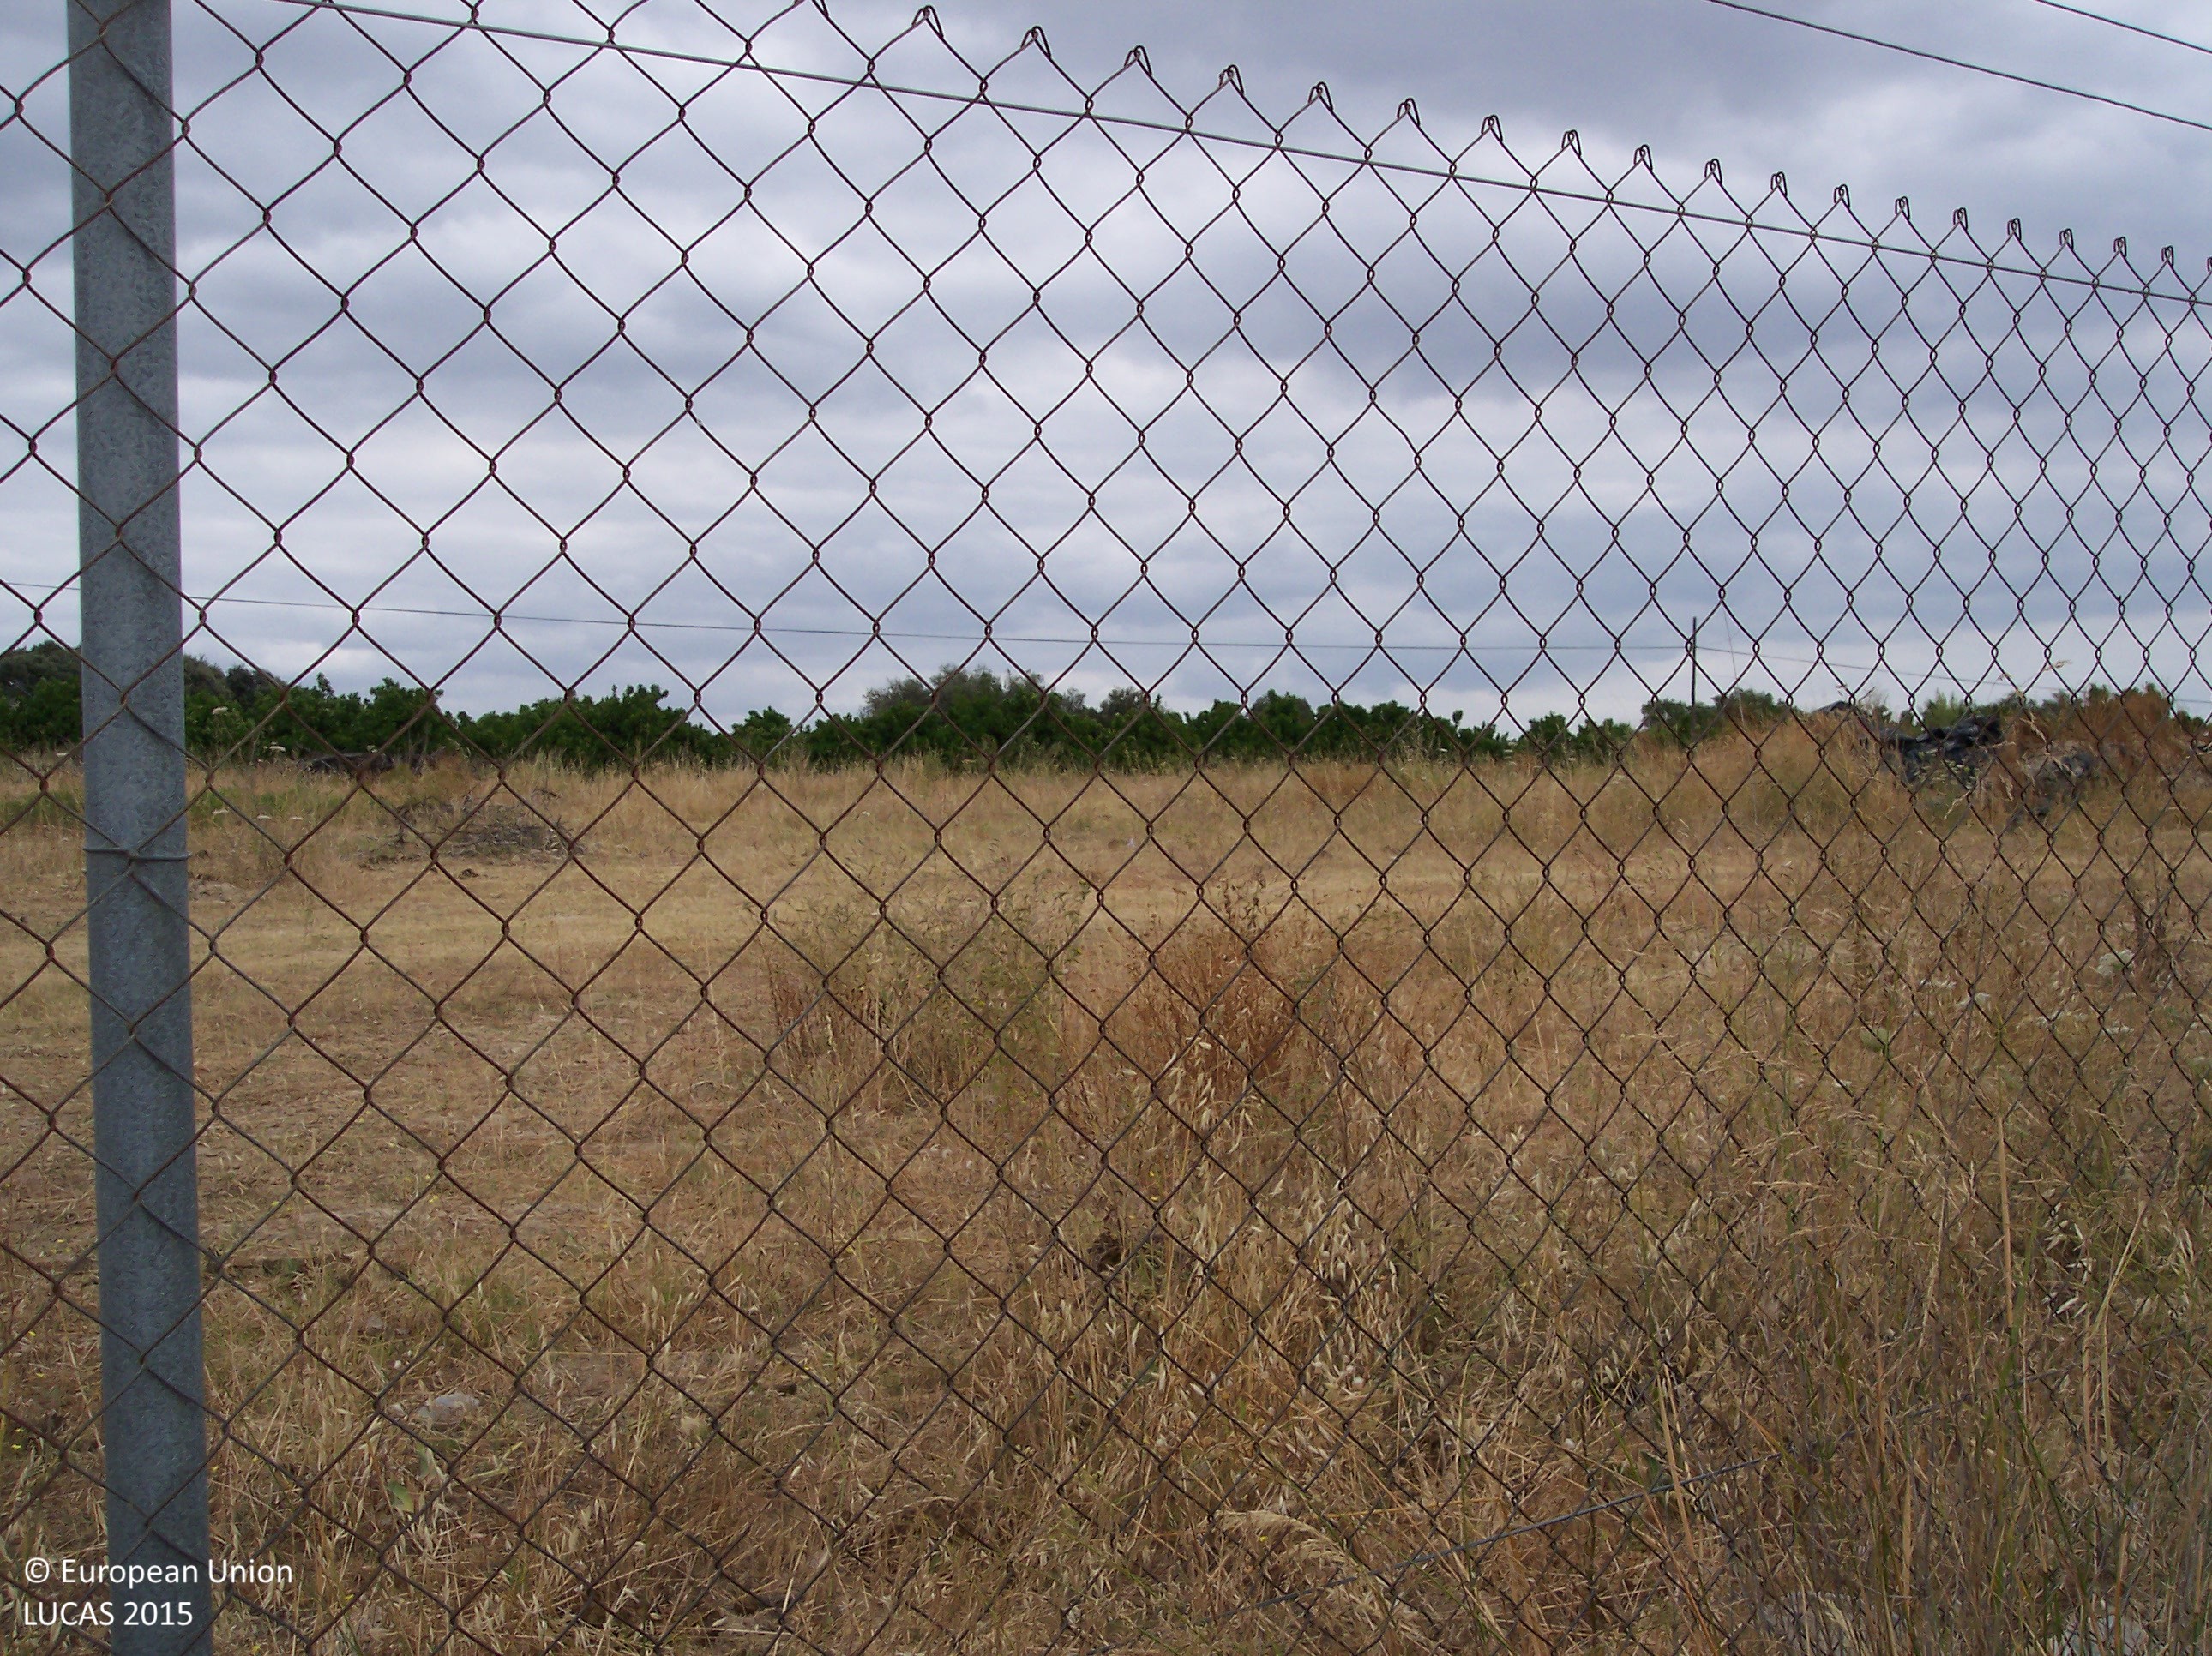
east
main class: Grassland
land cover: Grassland without tree/shrub cover
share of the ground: > 75 %
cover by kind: herbaceous plants 75 %, unconsolidated bare surface 20 %, shrubs 5 %
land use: Agriculture (excluding fallow land and kitchen gardens)
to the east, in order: Grassland without tree/shrub cover; Electric lines; Other citrus fruit; Broadleaved woodland; Fences; Tracks; Broadleaved woodland
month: June
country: ES
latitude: 37.3135
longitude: -6.3786
